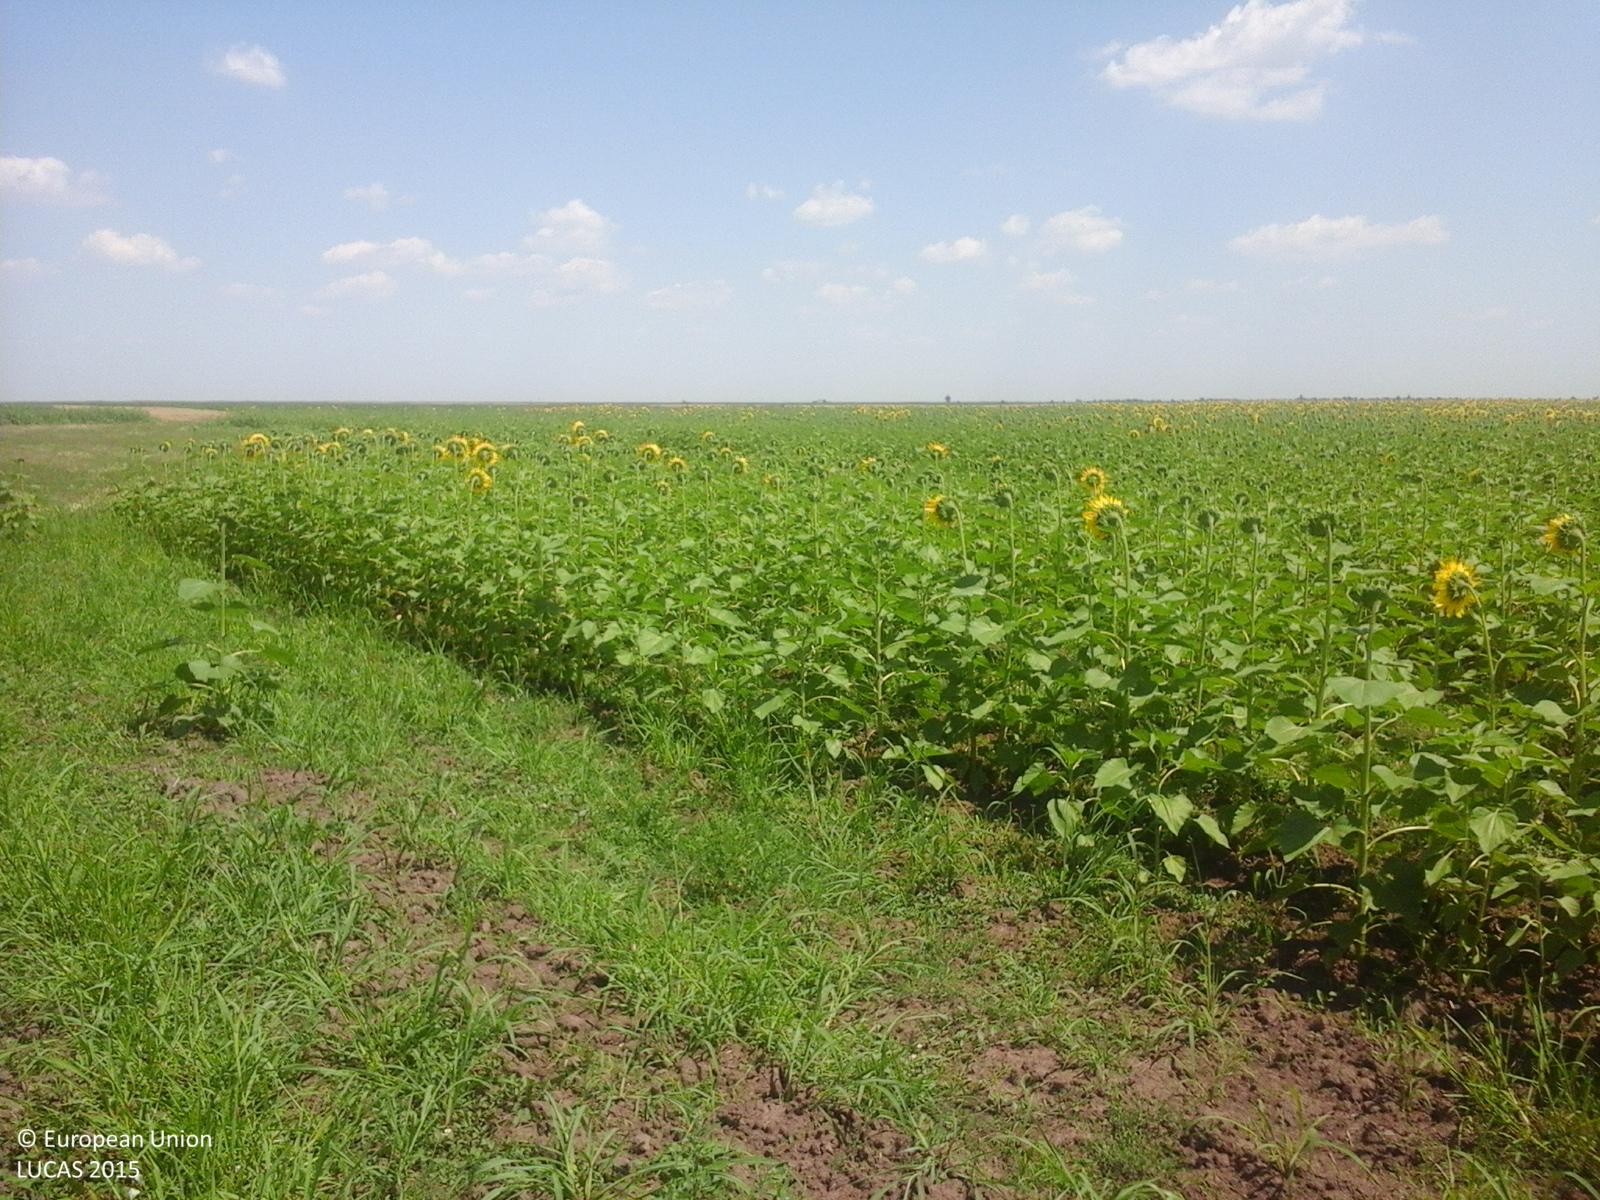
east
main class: Cropland
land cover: Sunflower
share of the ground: > 75 %
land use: Agriculture (excluding fallow land and kitchen gardens)
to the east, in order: Sunflower; Spontaneously vegetated surfaces; Sunflower; Tracks; Spontaneously vegetated surfaces
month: July
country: RO
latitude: 44.1731
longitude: 24.7184
